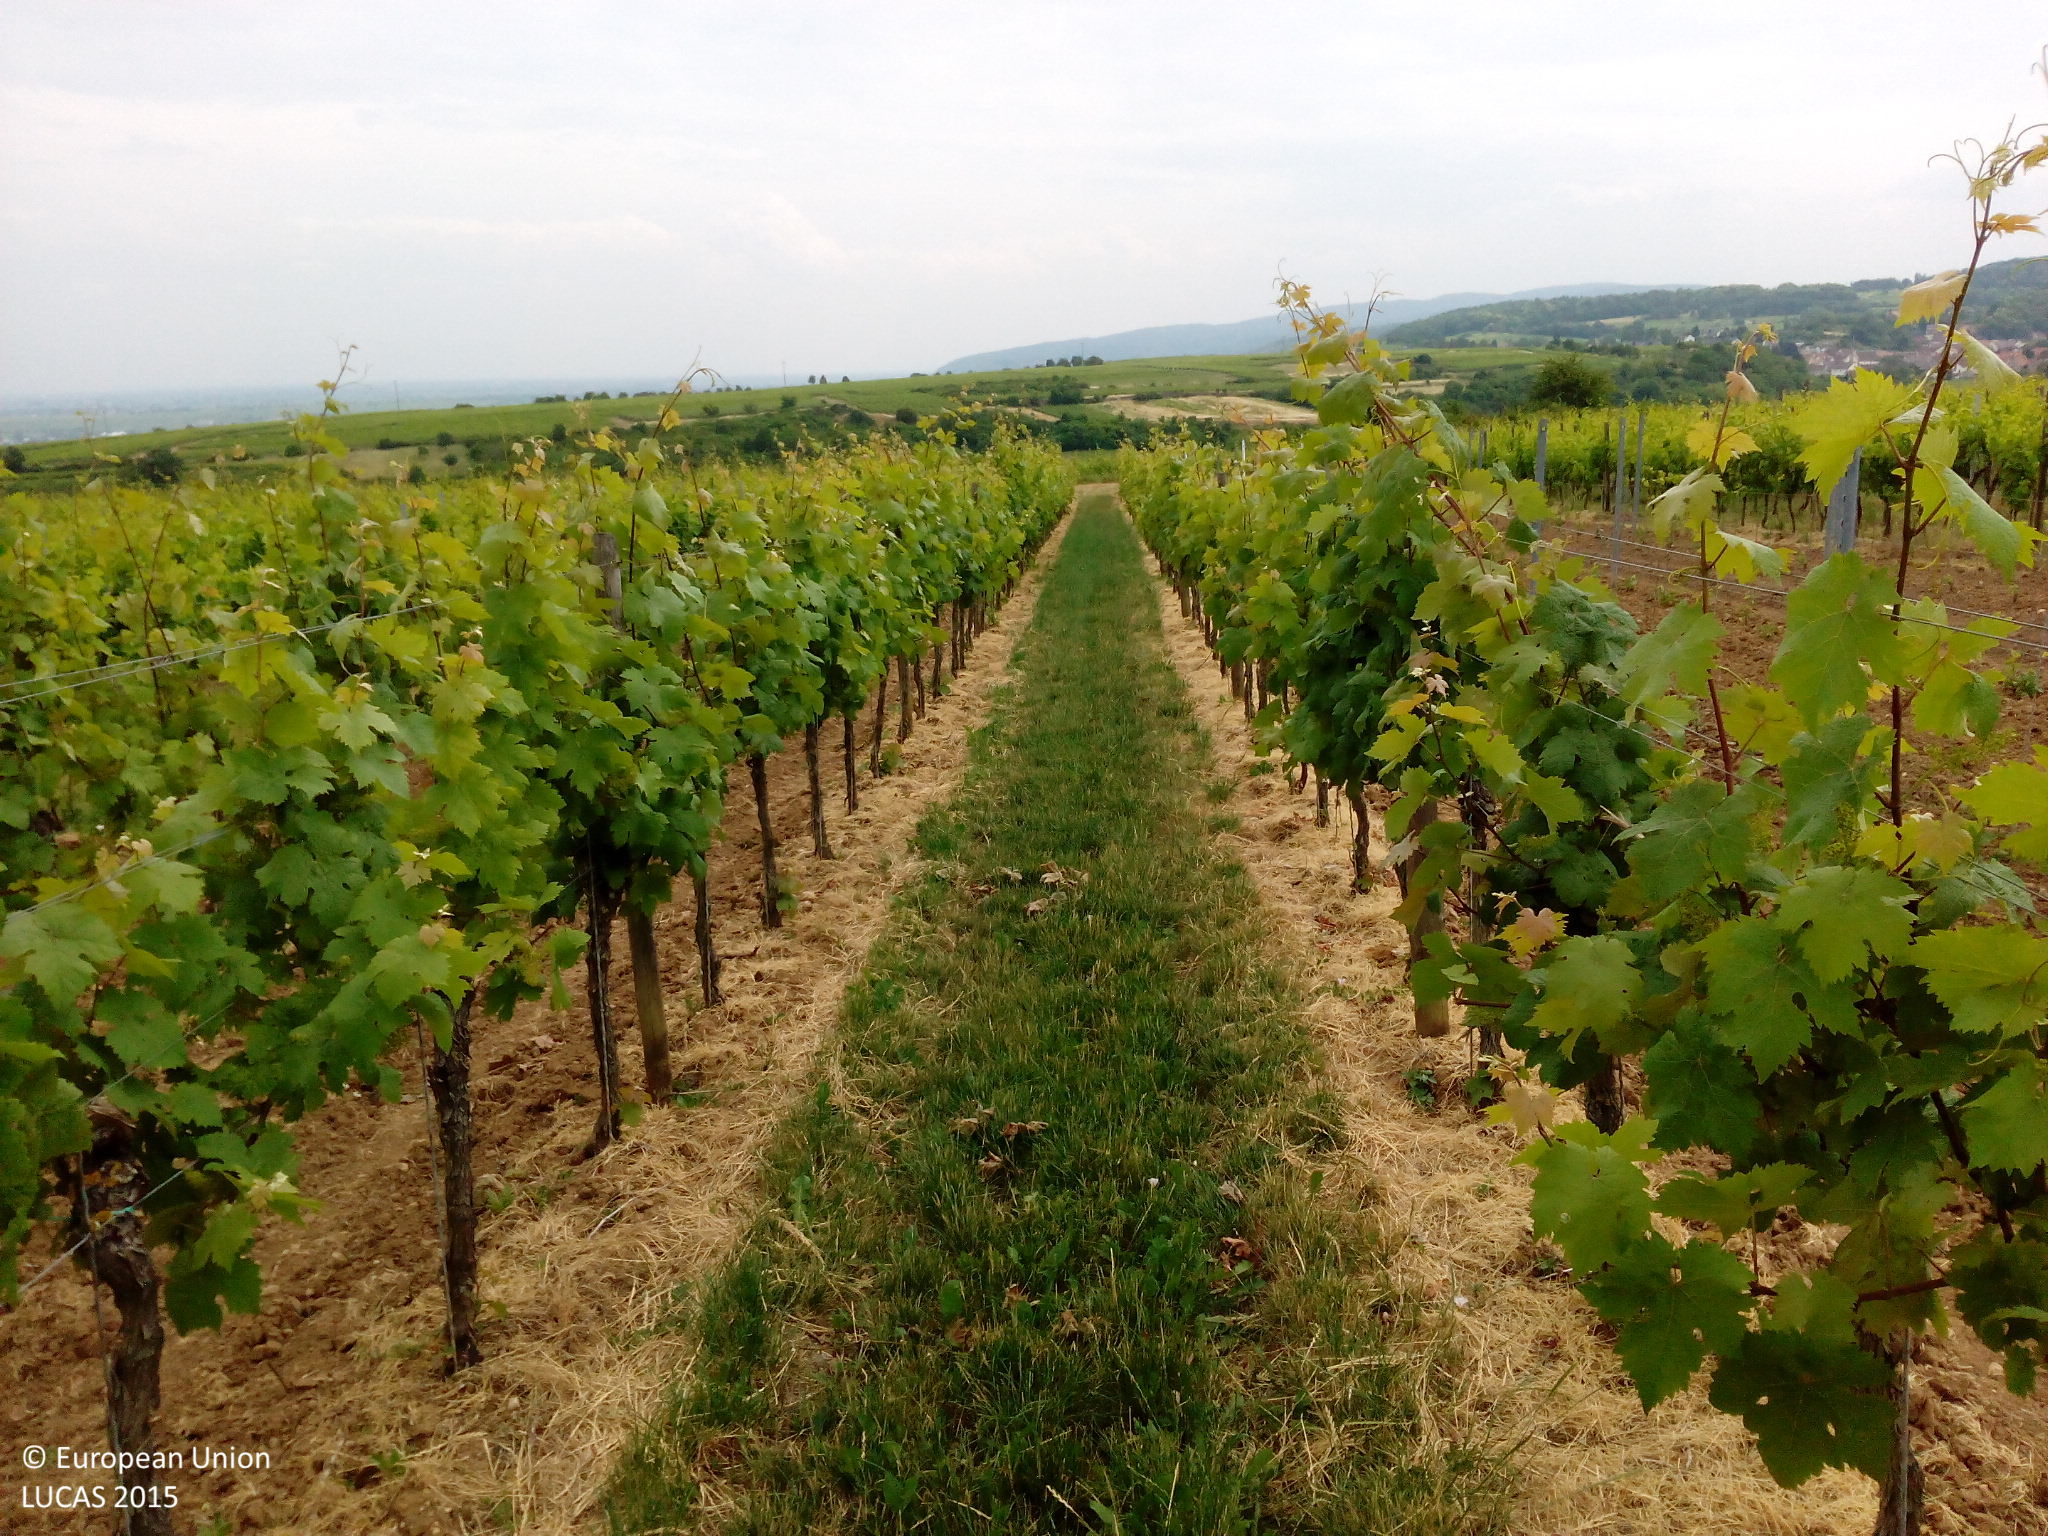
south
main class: Cropland
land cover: Vineyards
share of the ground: 10 - 25 %
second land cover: Spontaneously vegetated surfaces
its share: 25 - 50 %
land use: Agriculture (excluding fallow land and kitchen gardens)
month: June
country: DE
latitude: 49.5039
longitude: 8.1639
